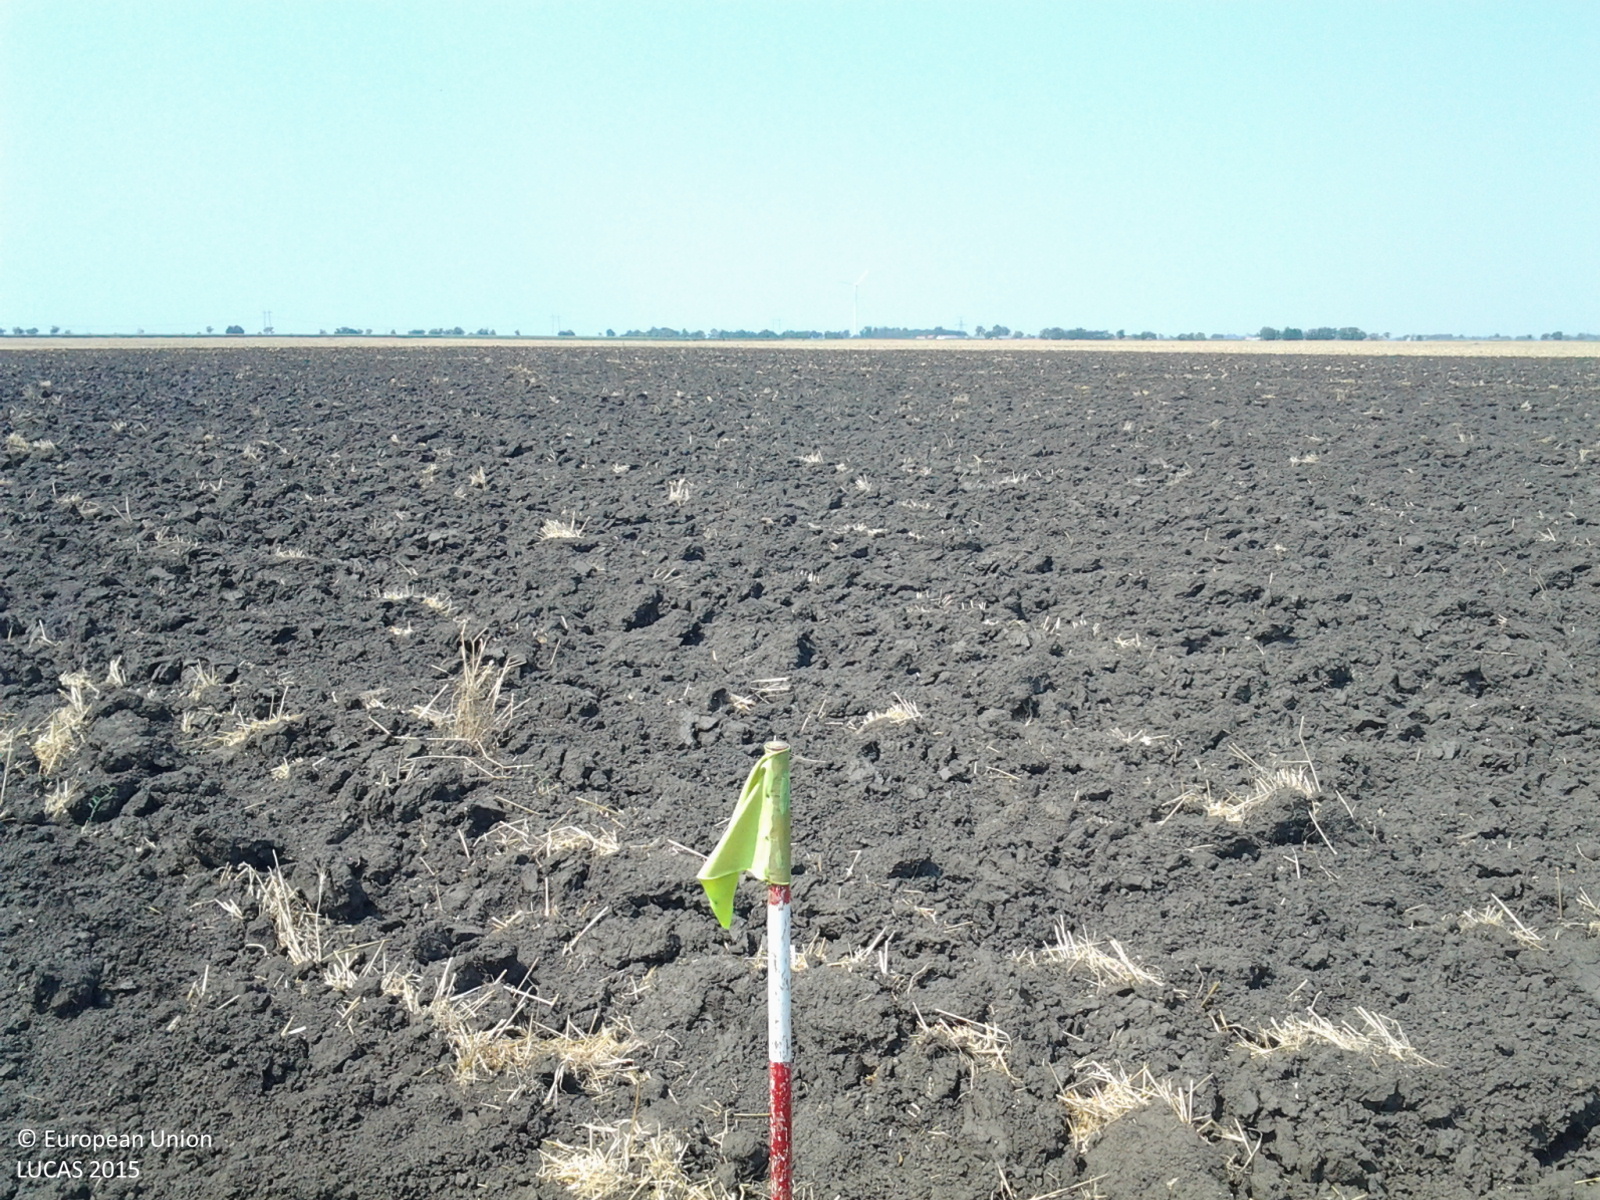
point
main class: Cropland
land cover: Common wheat
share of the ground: < 10 %
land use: Agriculture (excluding fallow land and kitchen gardens)
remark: Tilled/Sowed
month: July
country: HU
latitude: 47.1414
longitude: 20.4857
